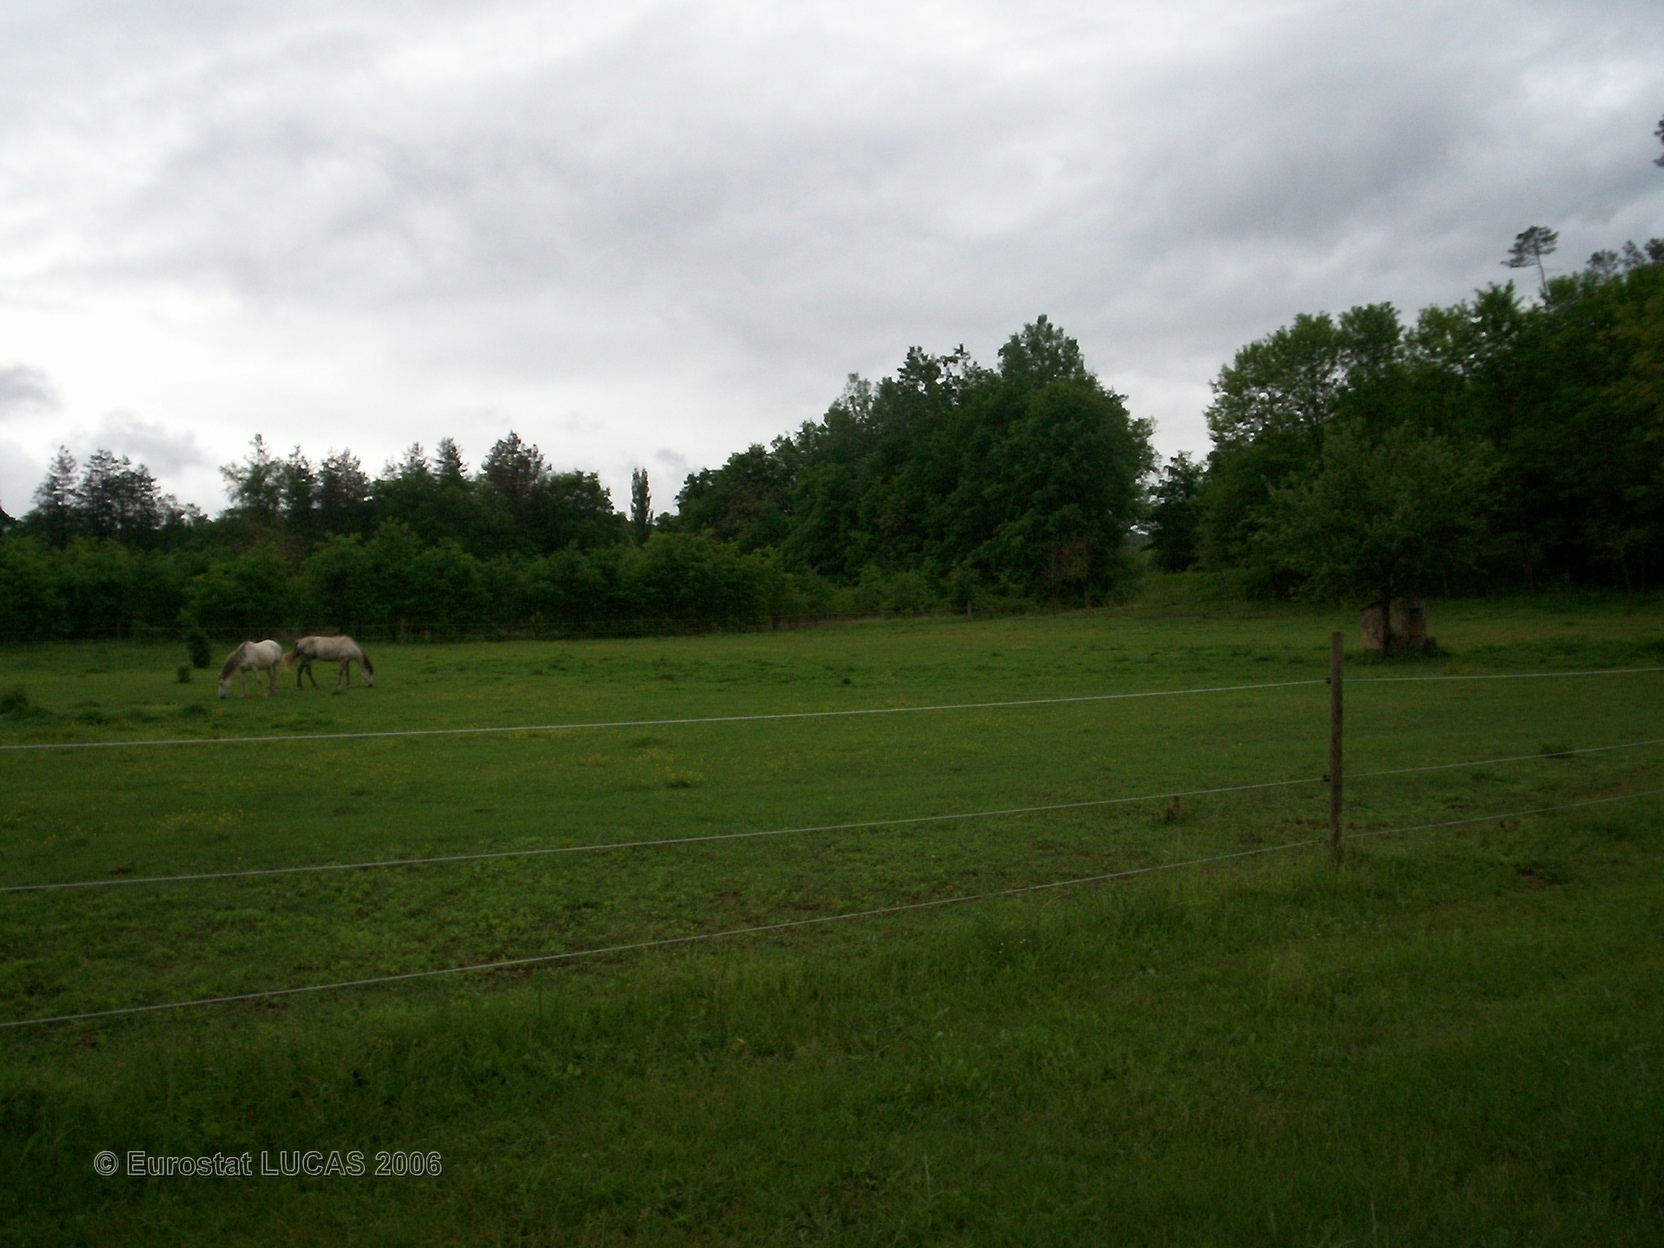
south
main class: Grassland
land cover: Grassland without tree/shrub cover
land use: Agriculture (excluding fallow land and kitchen gardens)
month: May
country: FR
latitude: 44.7876
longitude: 1.3635
